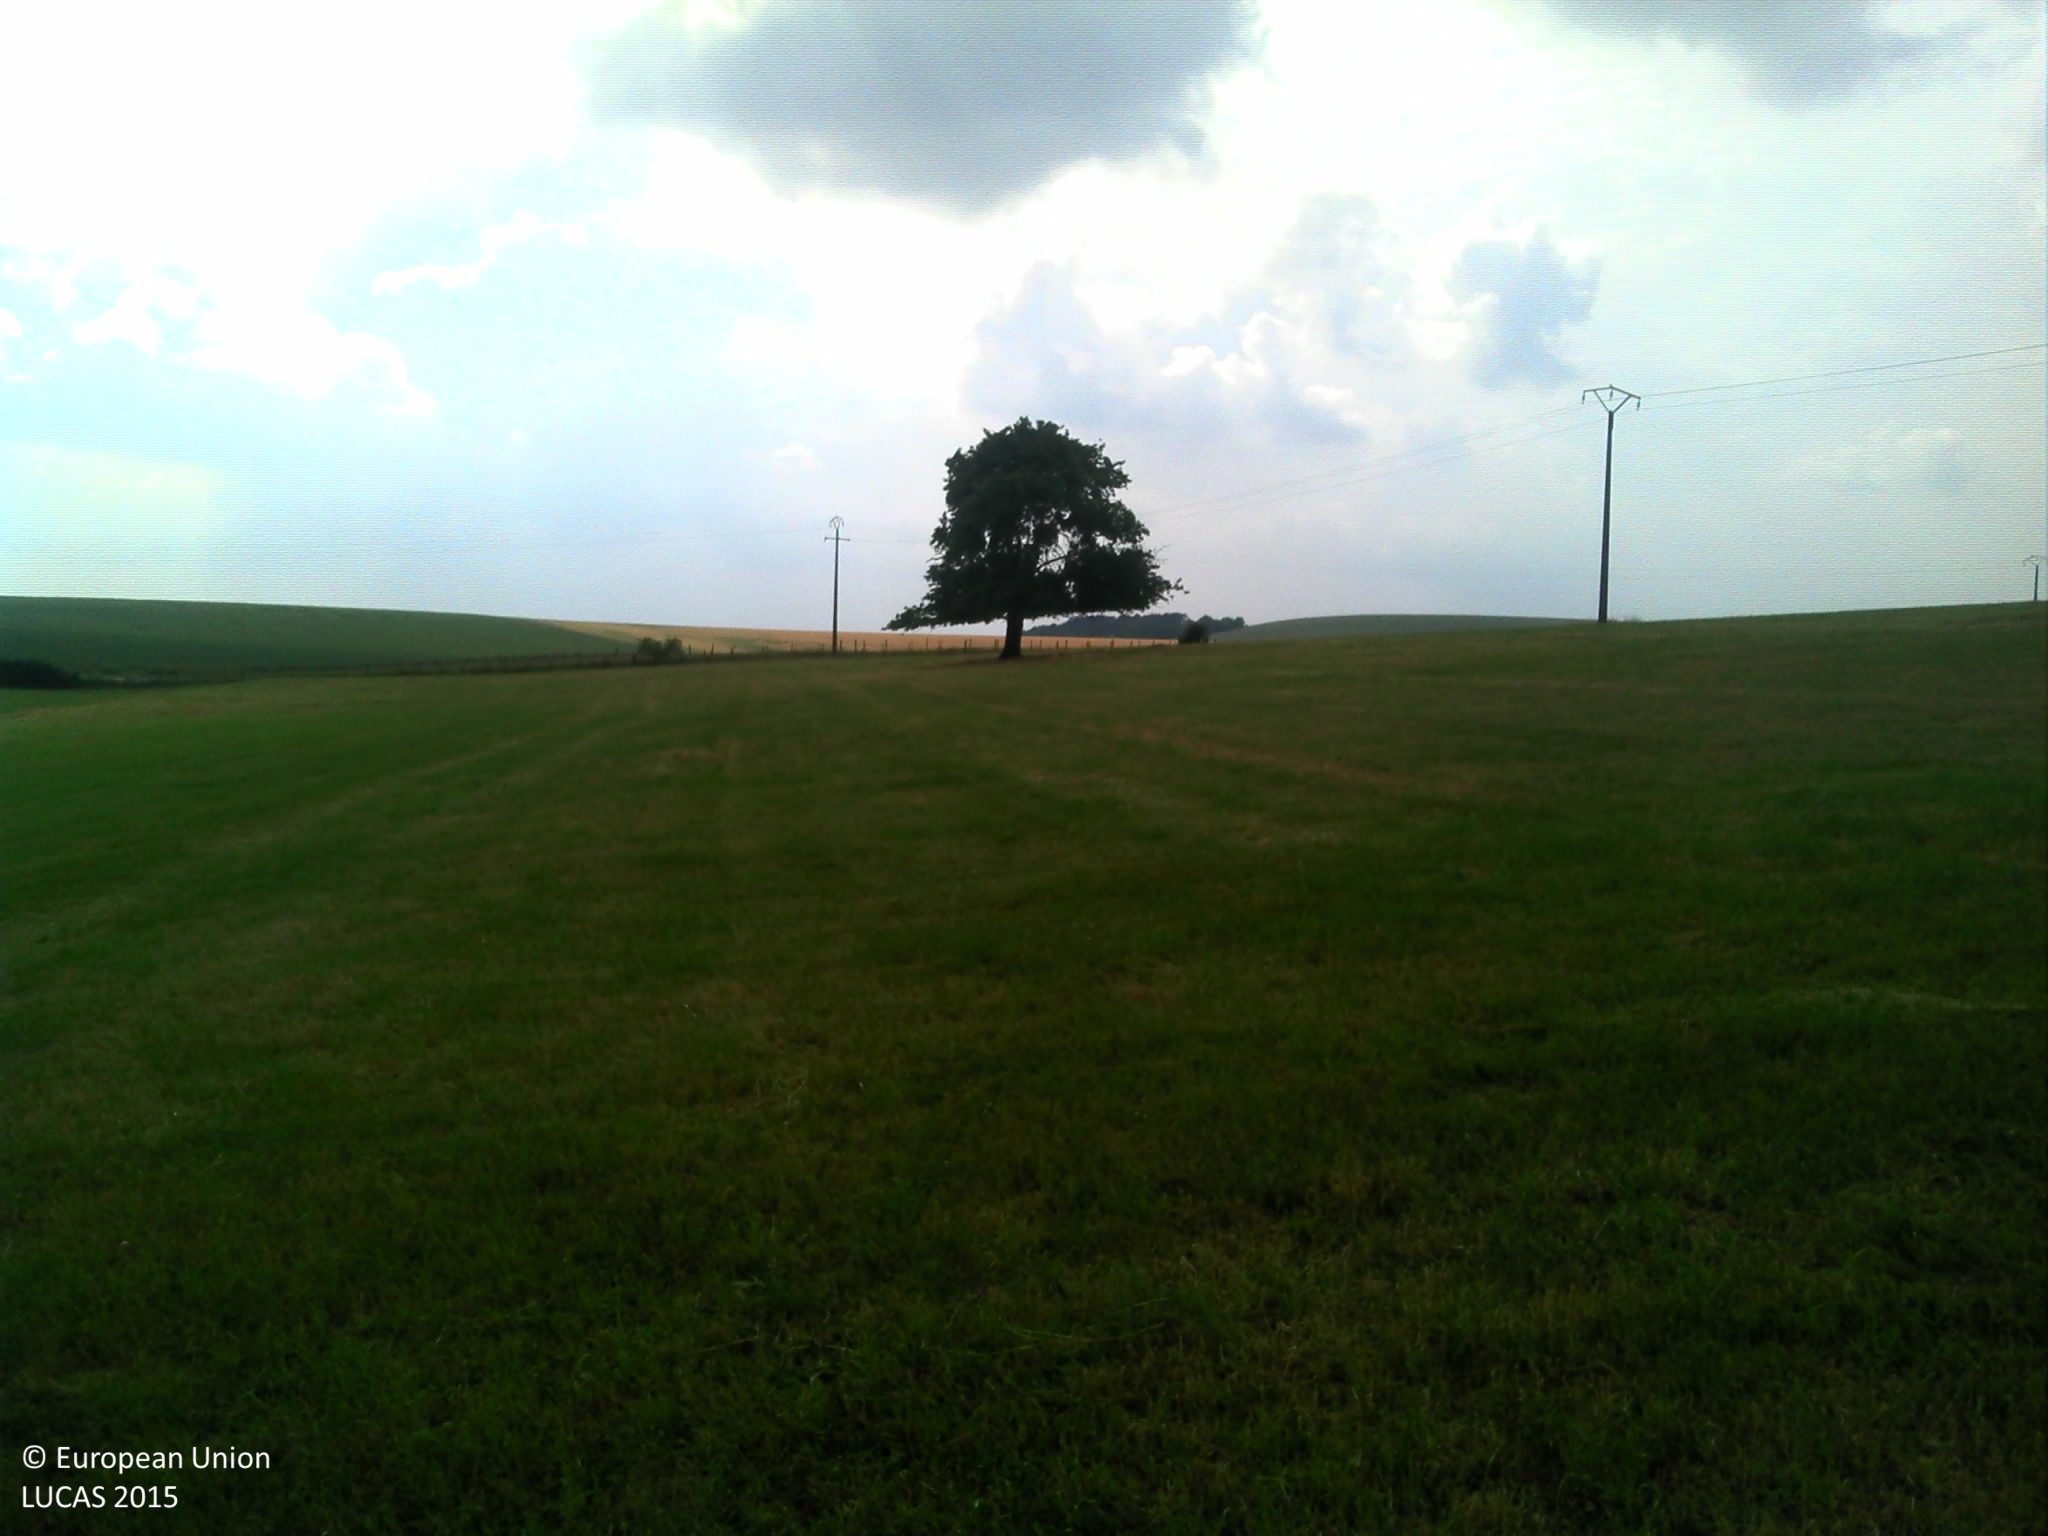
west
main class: Grassland
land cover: Grassland without tree/shrub cover
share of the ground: > 75 %
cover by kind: herbaceous plants 100 %
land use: Agriculture (excluding fallow land and kitchen gardens)
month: June
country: FR
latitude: 48.2687
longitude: 4.9194
